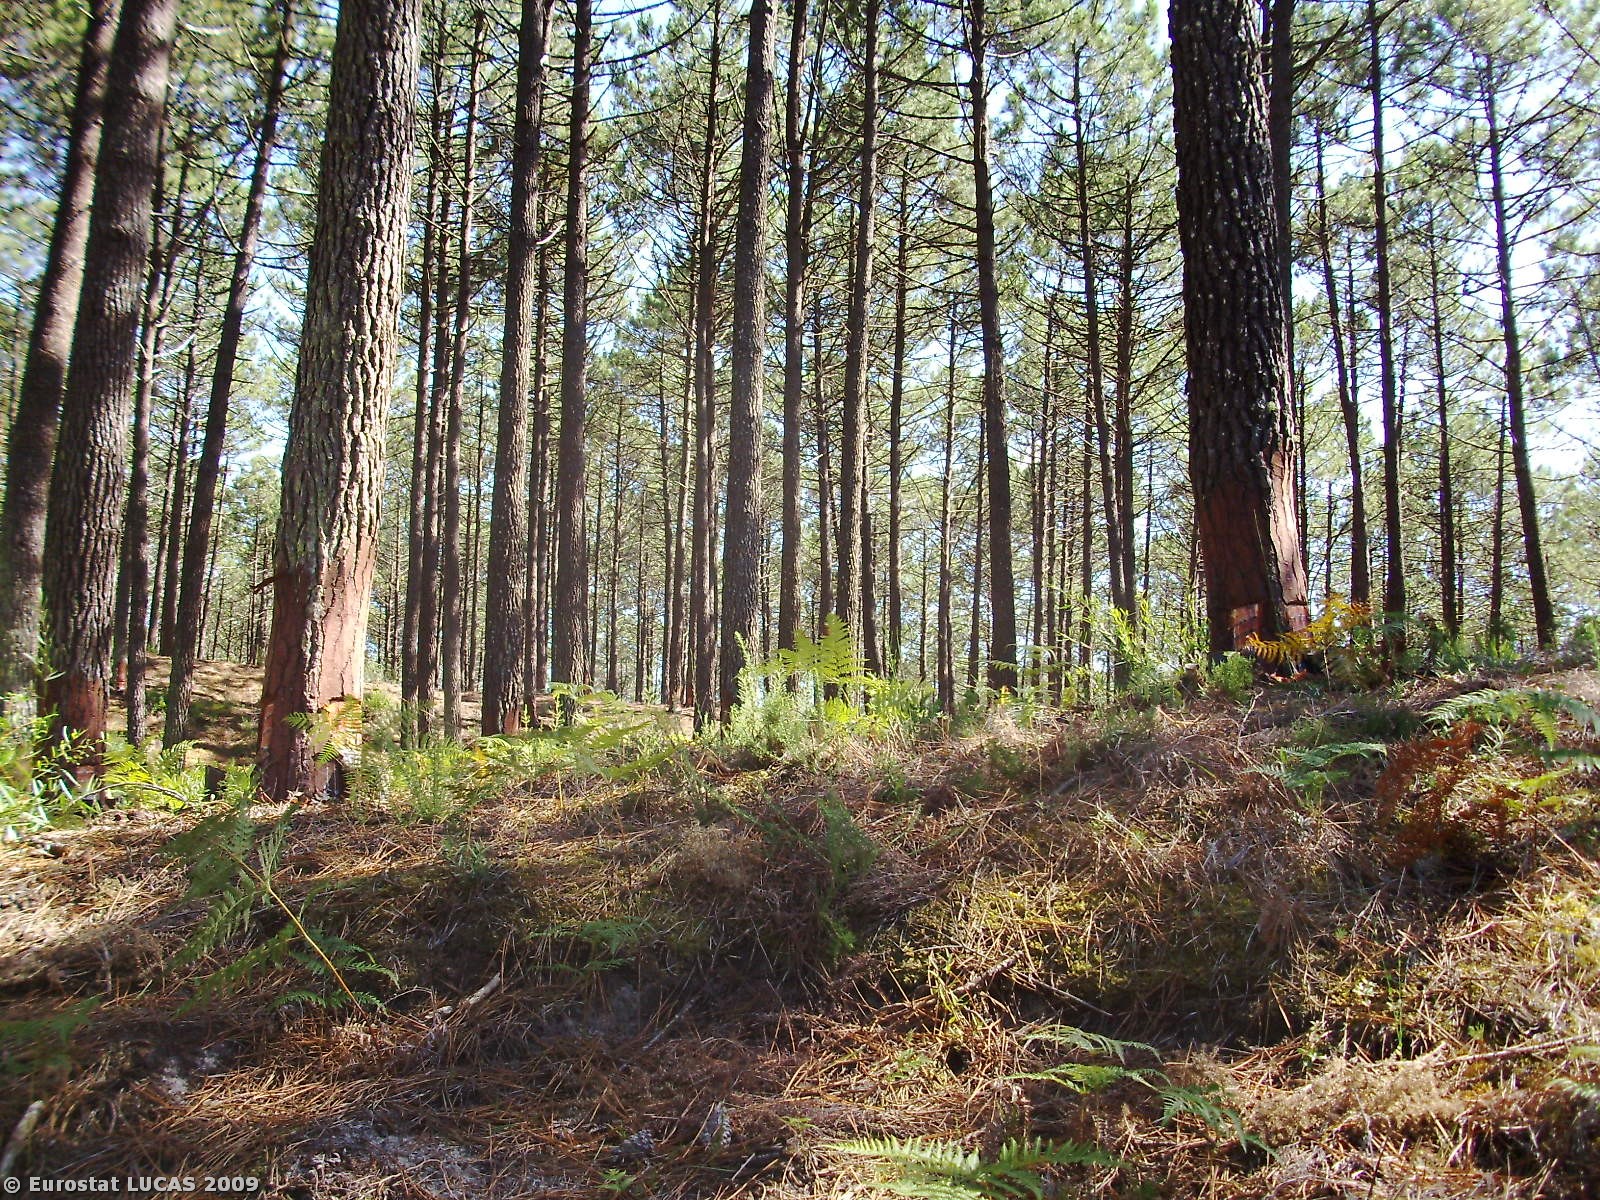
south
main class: Woodland
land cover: Coniferous woodland
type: coniferous forest of the mediterranean region
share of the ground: > 75 %
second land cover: Shrubland with sparse tree cover
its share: 10 - 25 %
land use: Forestry
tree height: > 5 m
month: July
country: PT
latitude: 39.7244
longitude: -9.0027
